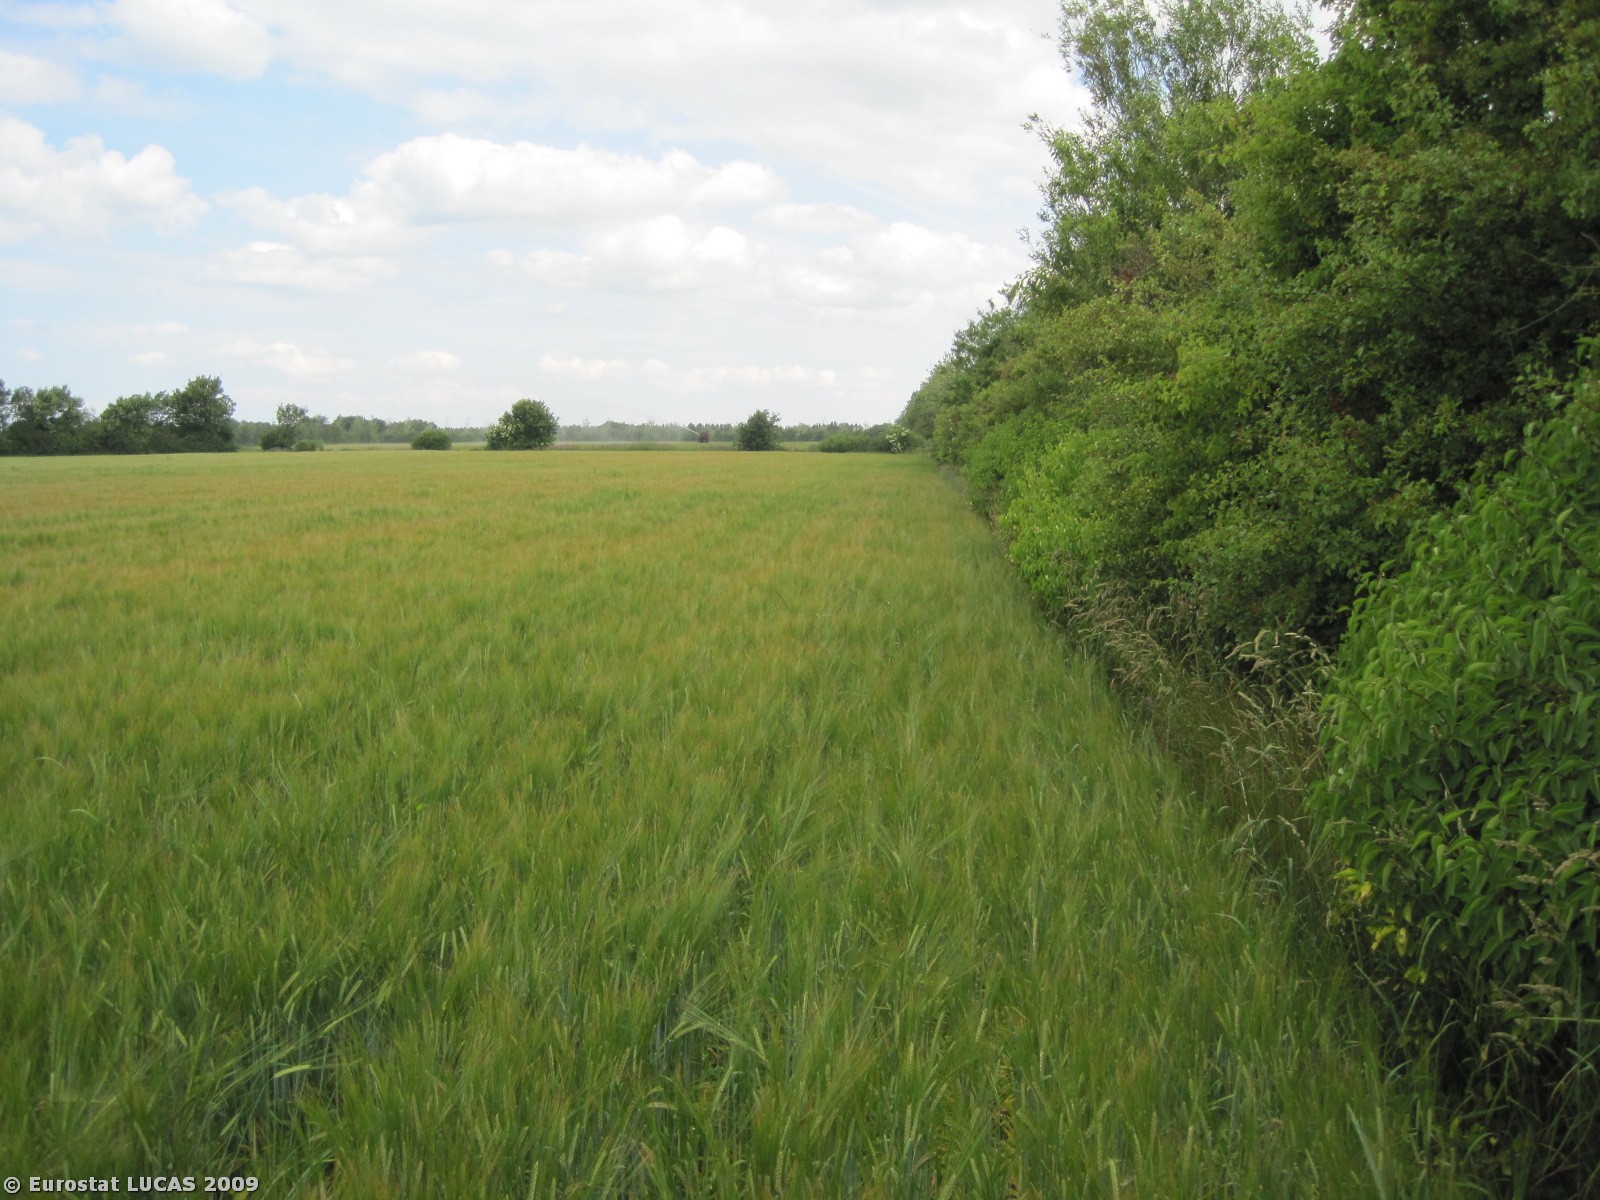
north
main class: Cropland
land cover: Barley
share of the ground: > 75 %
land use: Agriculture (excluding fallow land and kitchen gardens)
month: June
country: DK
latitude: 56.3441
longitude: 8.8204
